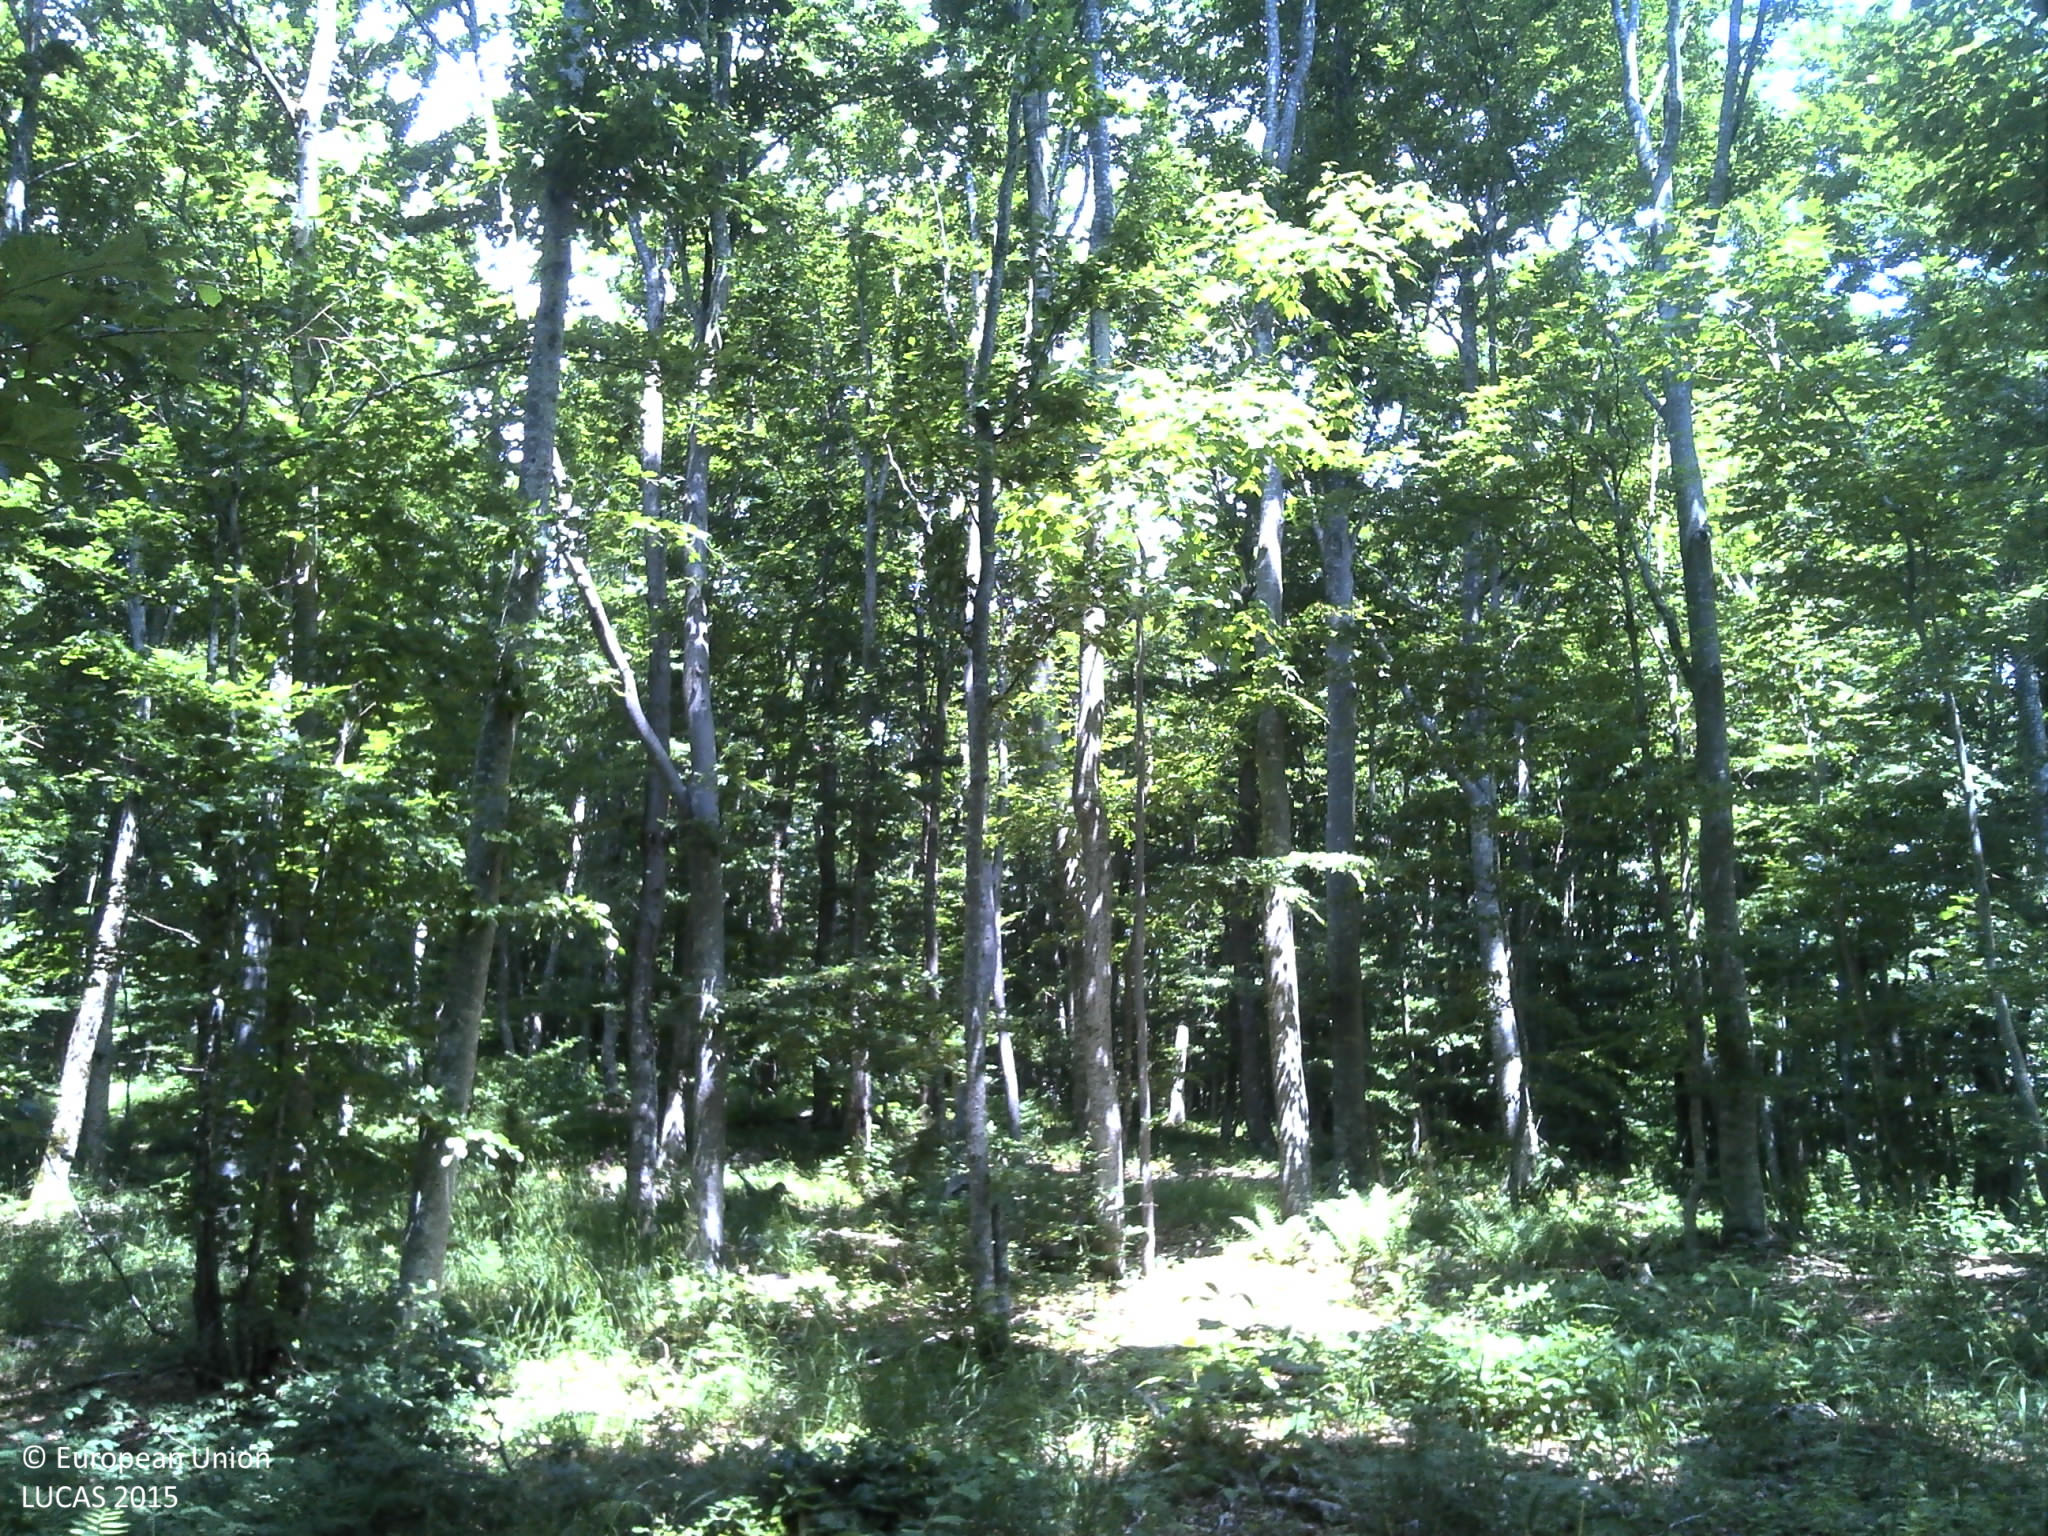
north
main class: Woodland
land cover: Broadleaved woodland
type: mountainous beech forest
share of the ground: > 75 %
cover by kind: broadleaved forest trees 95 %, consolidated bare surface 5 %
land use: Forestry
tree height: > 5 m
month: June
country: HR
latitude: 44.5042
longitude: 15.9683
